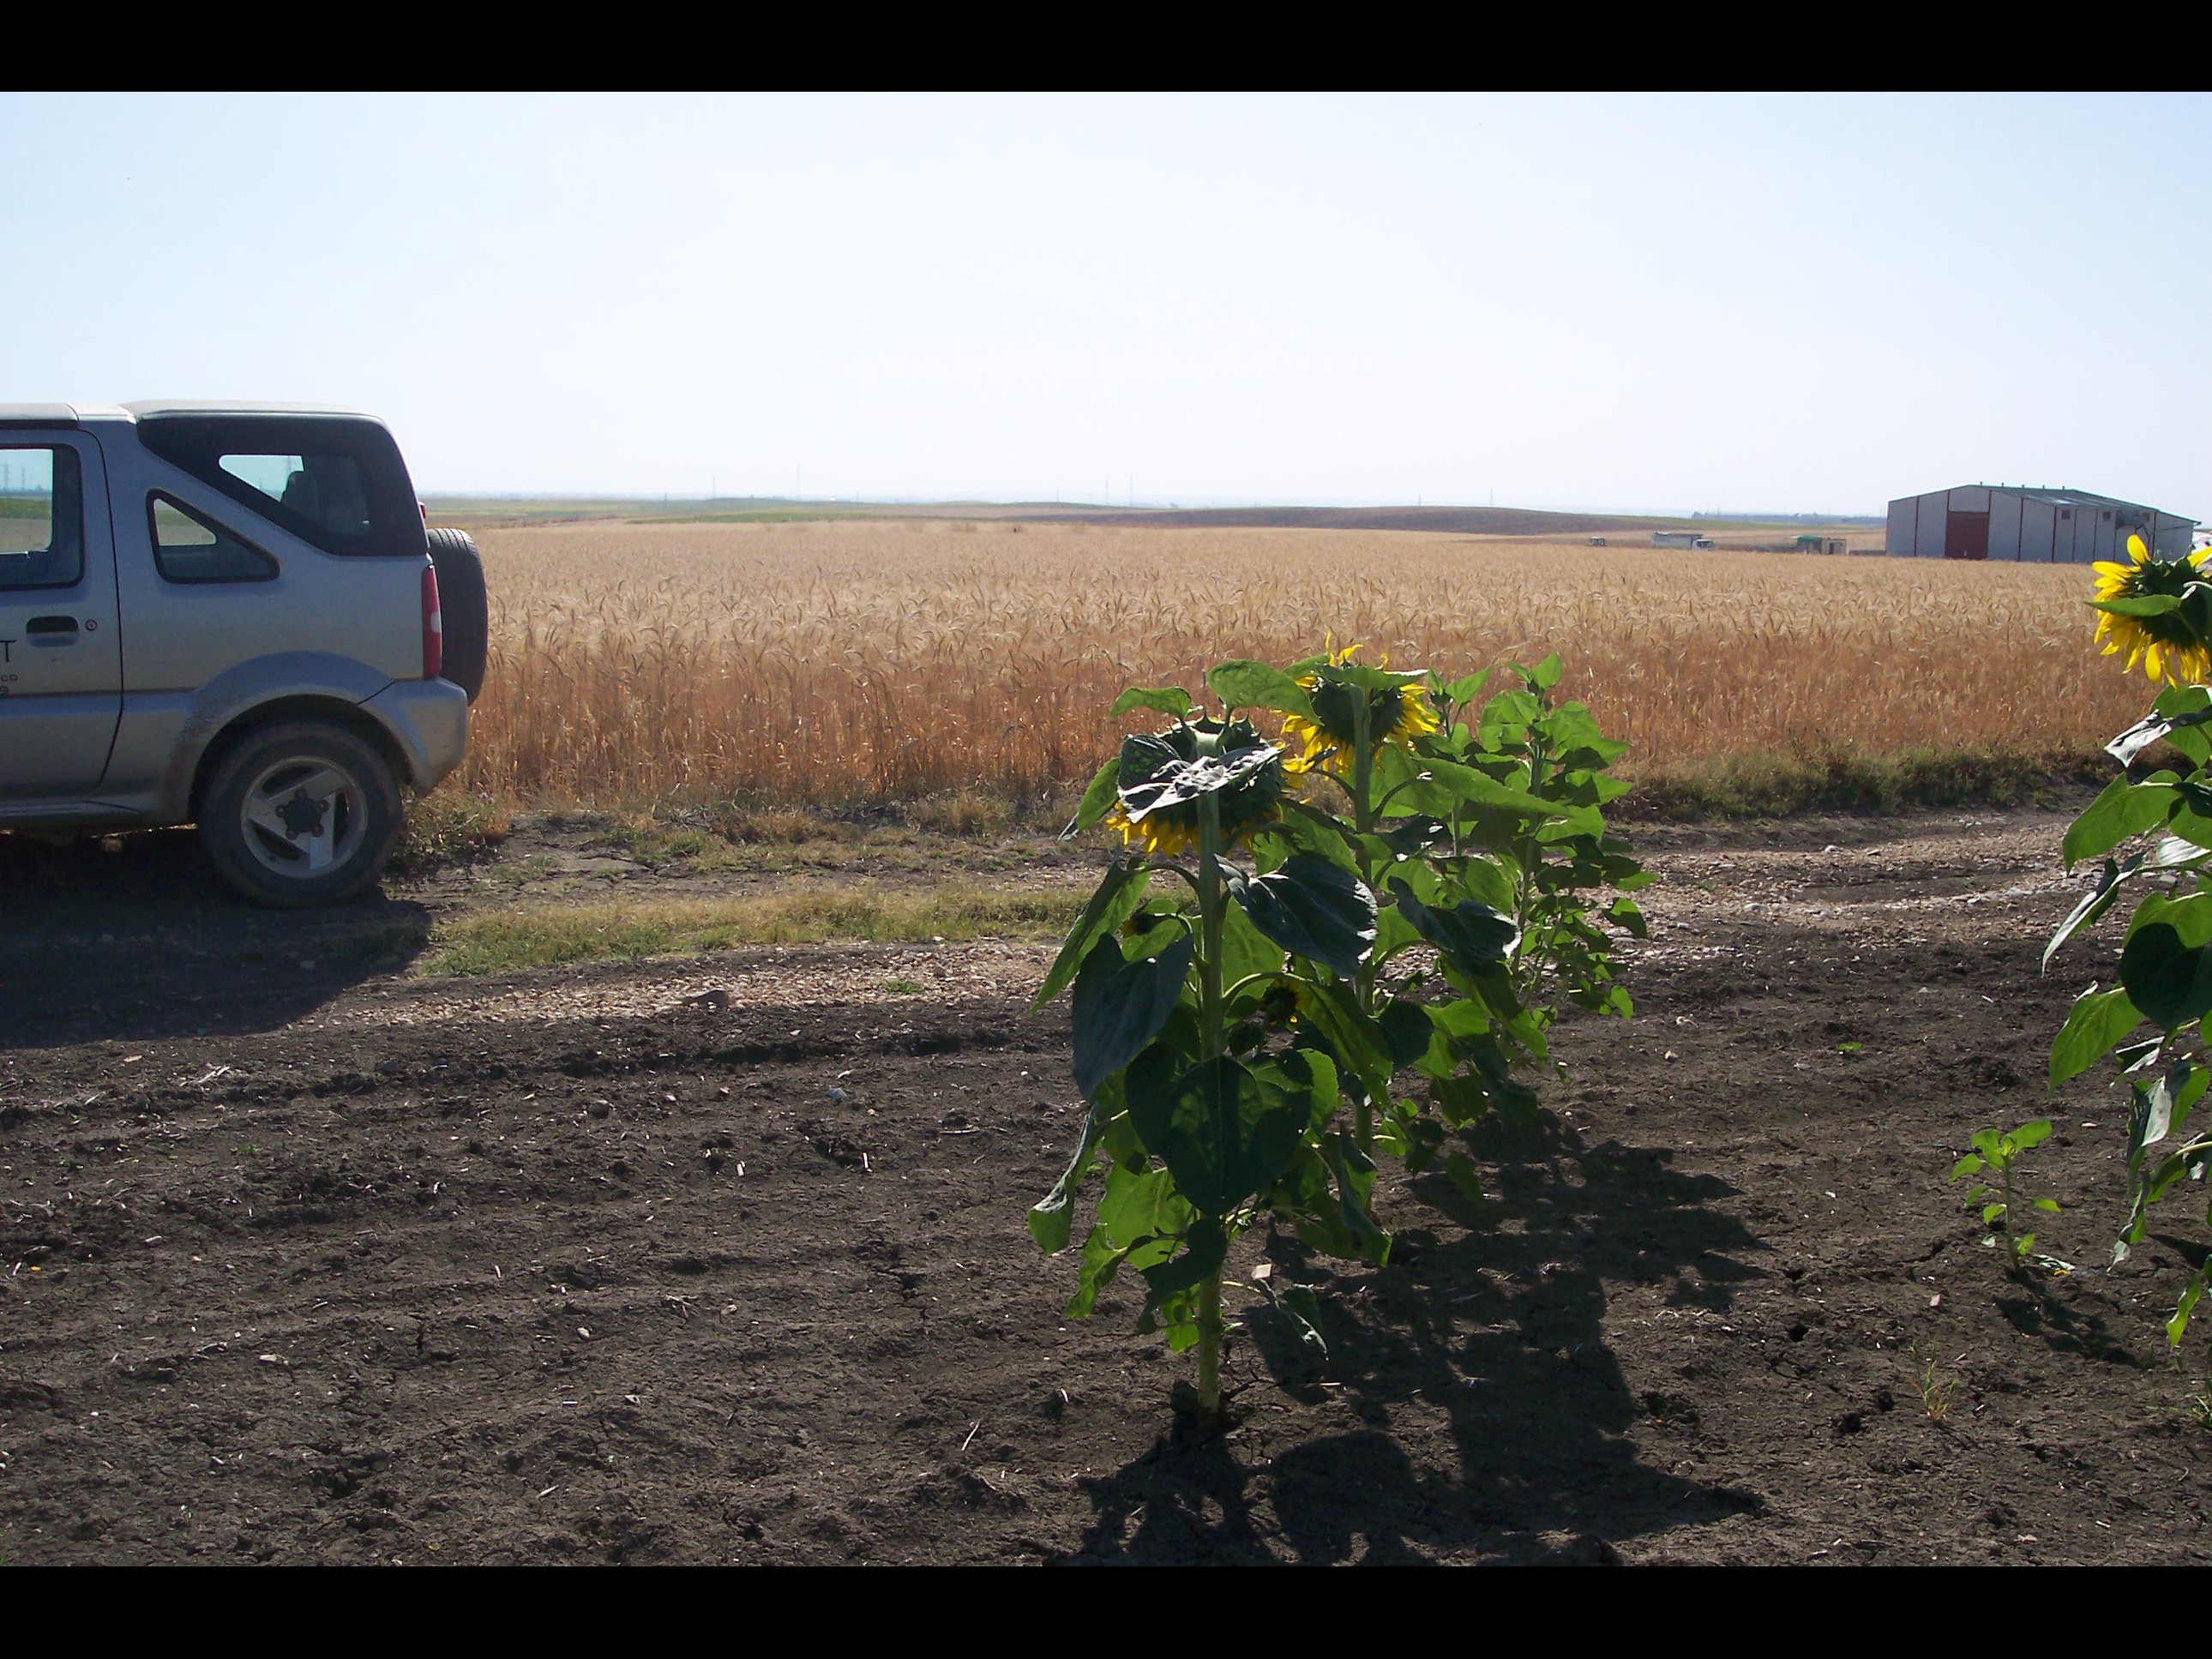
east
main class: Cropland
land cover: Sunflower
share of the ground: > 75 %
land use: Agriculture (excluding fallow land and kitchen gardens)
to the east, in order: Sunflower; Tracks; Common wheat
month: June
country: ES
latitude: 37.4733
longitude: -6.0950
